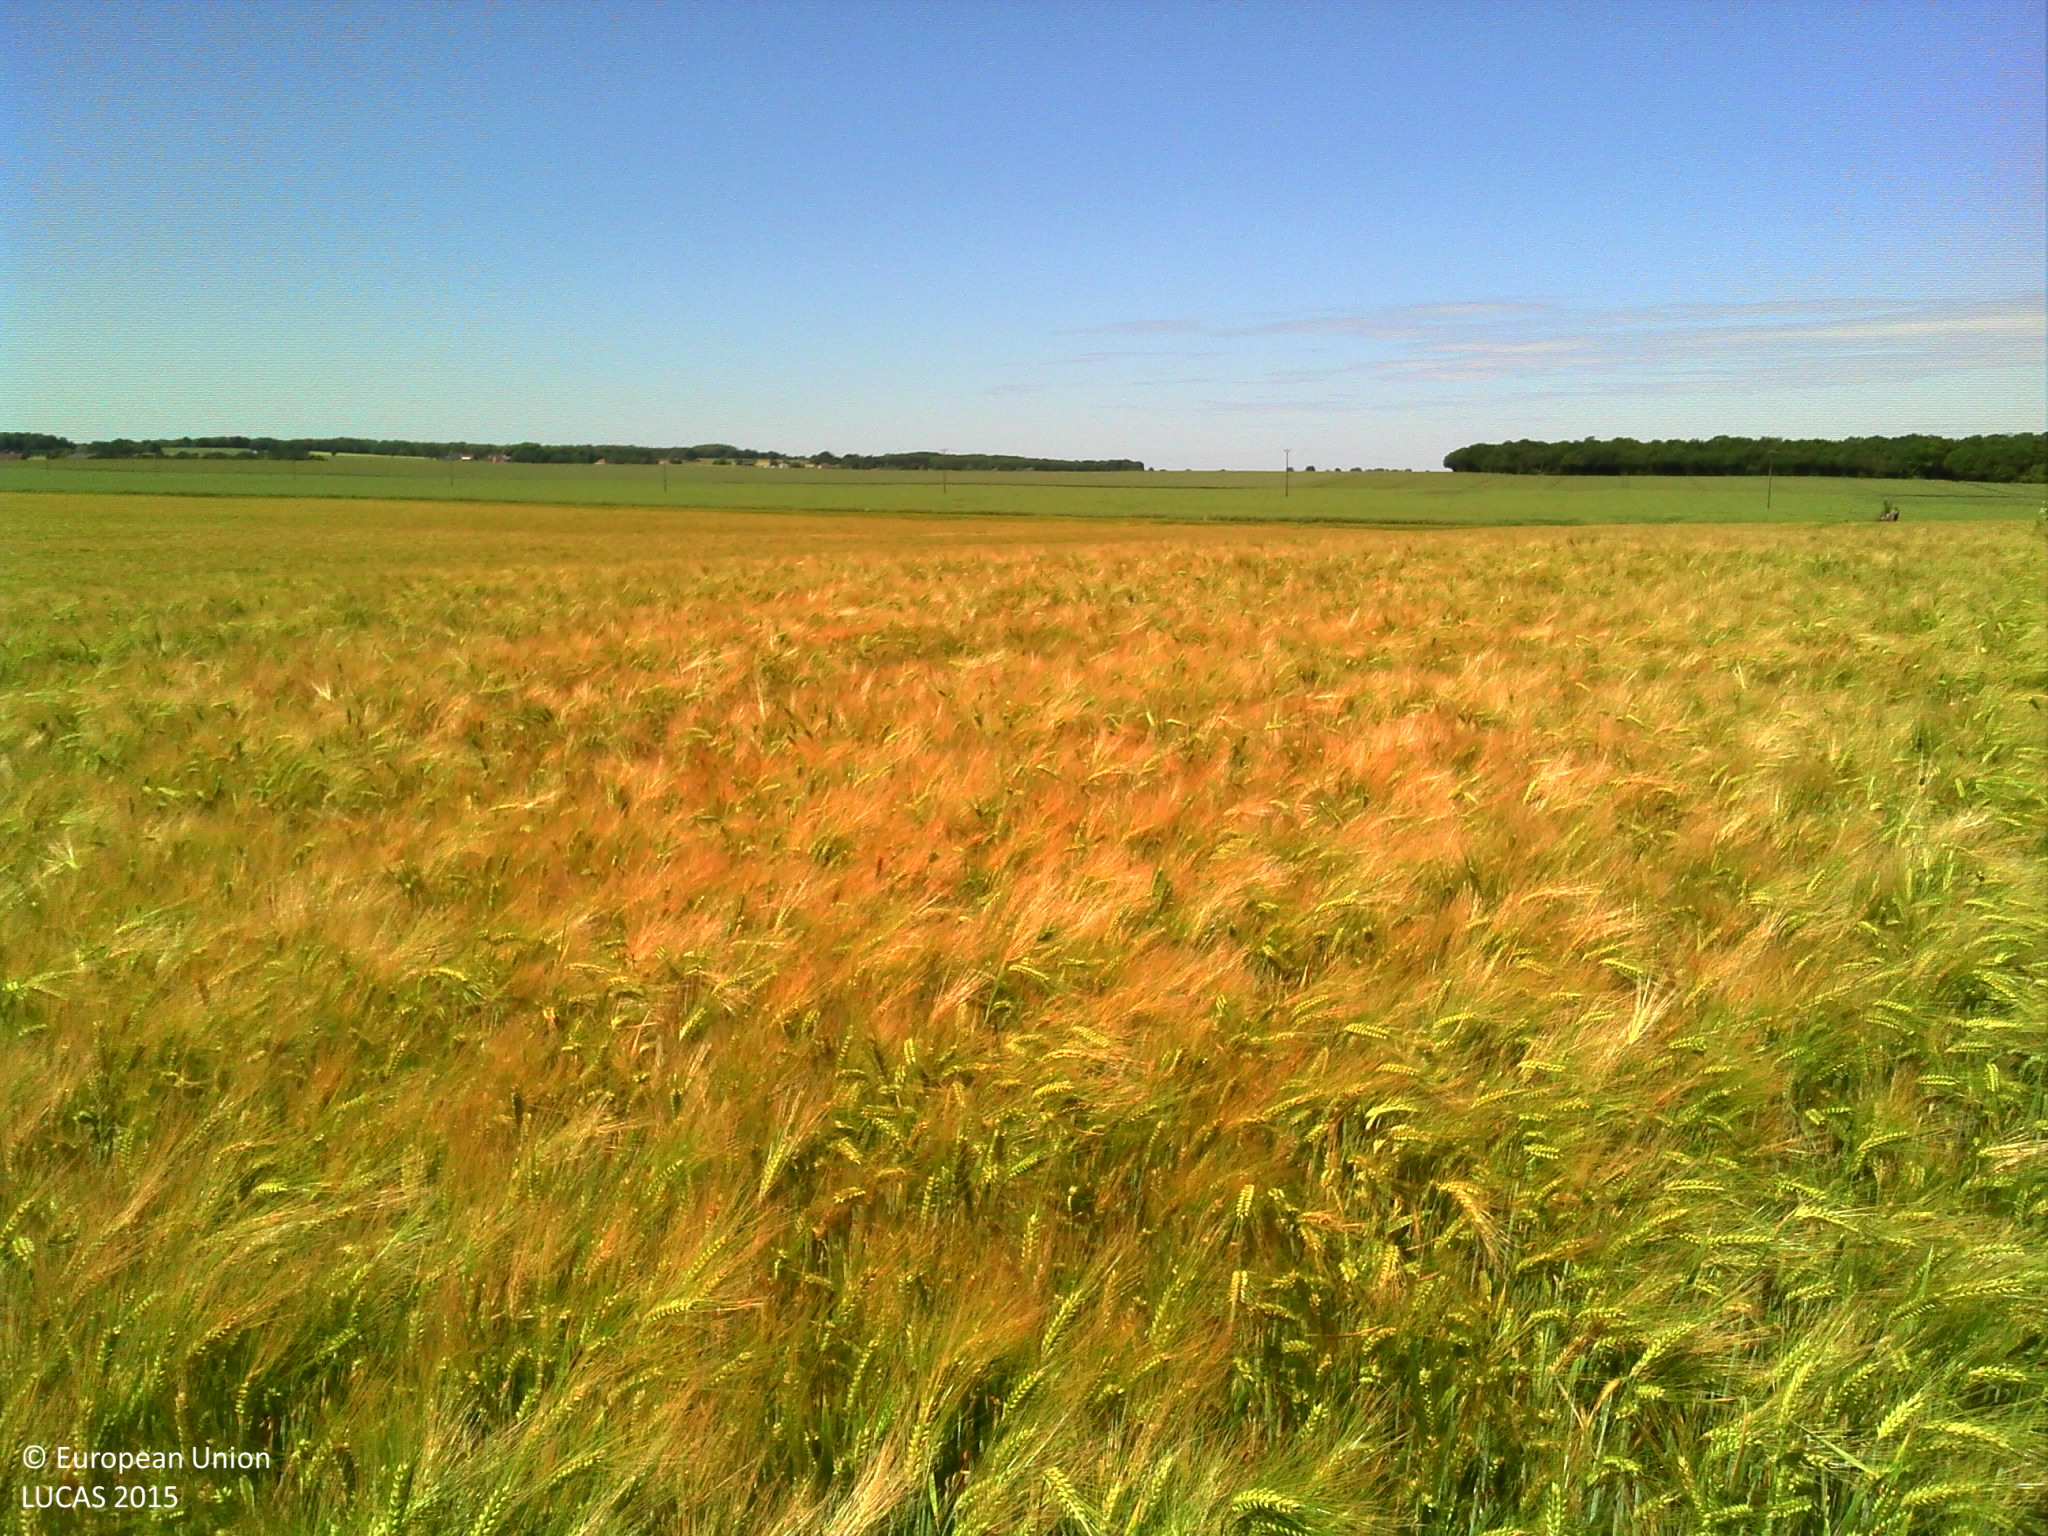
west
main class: Cropland
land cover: Barley
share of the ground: > 75 %
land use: Agriculture (excluding fallow land and kitchen gardens)
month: June
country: FR
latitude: 47.0567
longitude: 2.9256
